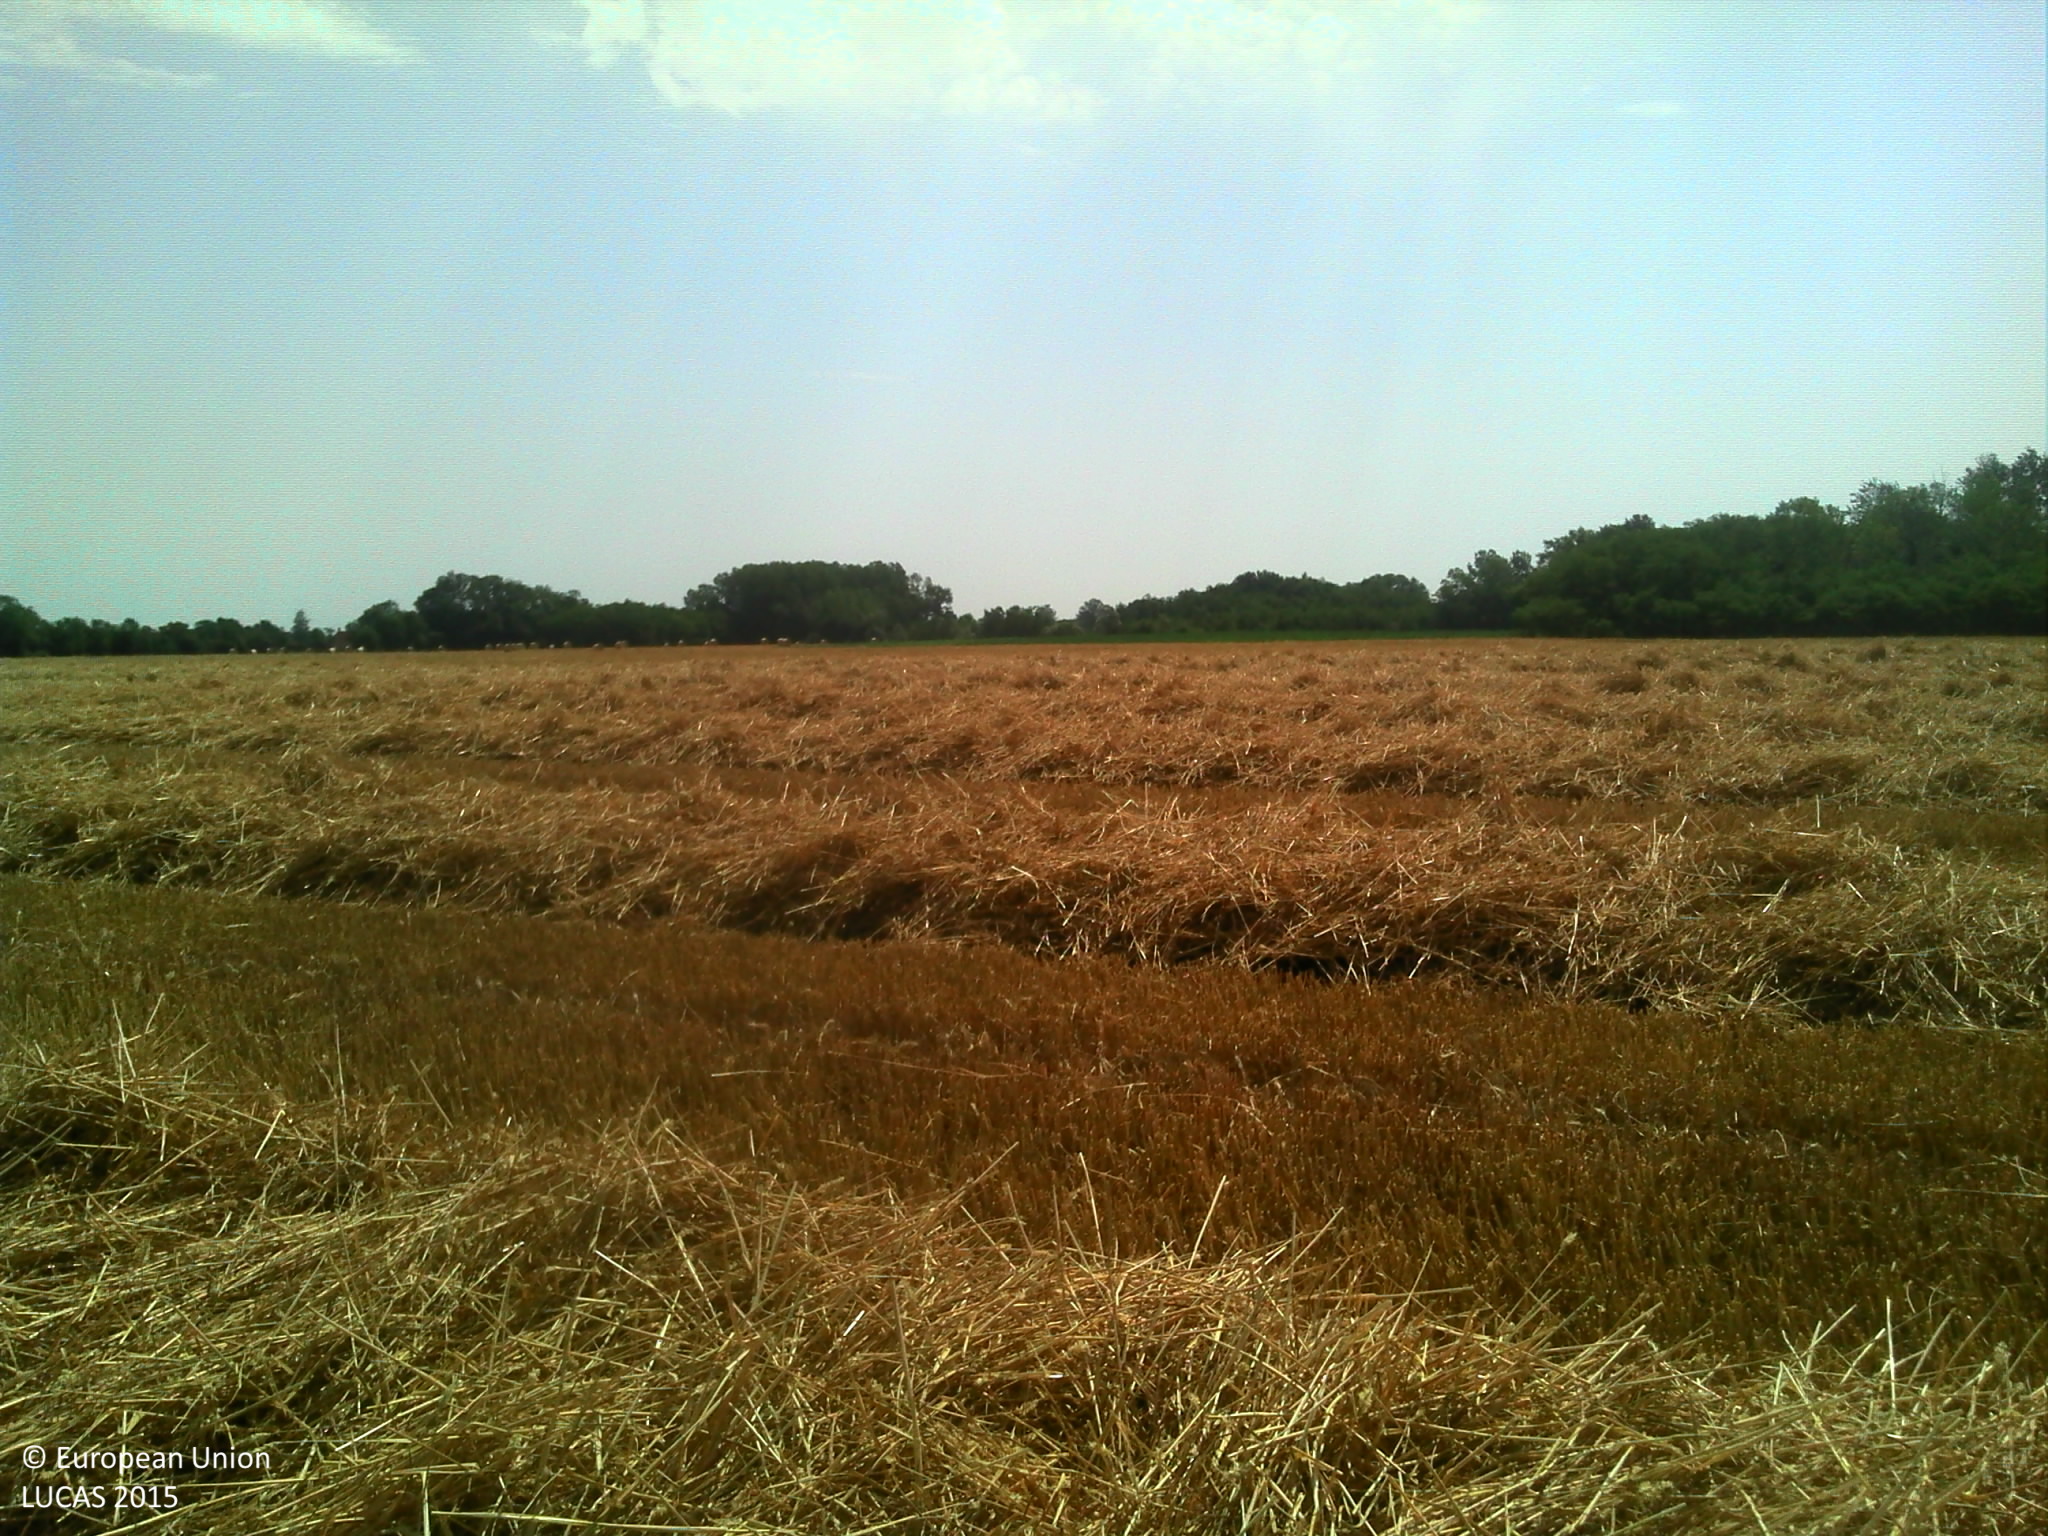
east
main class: Cropland
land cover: Triticale
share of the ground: > 75 %
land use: Agriculture (excluding fallow land and kitchen gardens)
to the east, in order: Triticale; Common wheat; Other bare soil
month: July
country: FR
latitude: 46.8621
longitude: 5.3188
